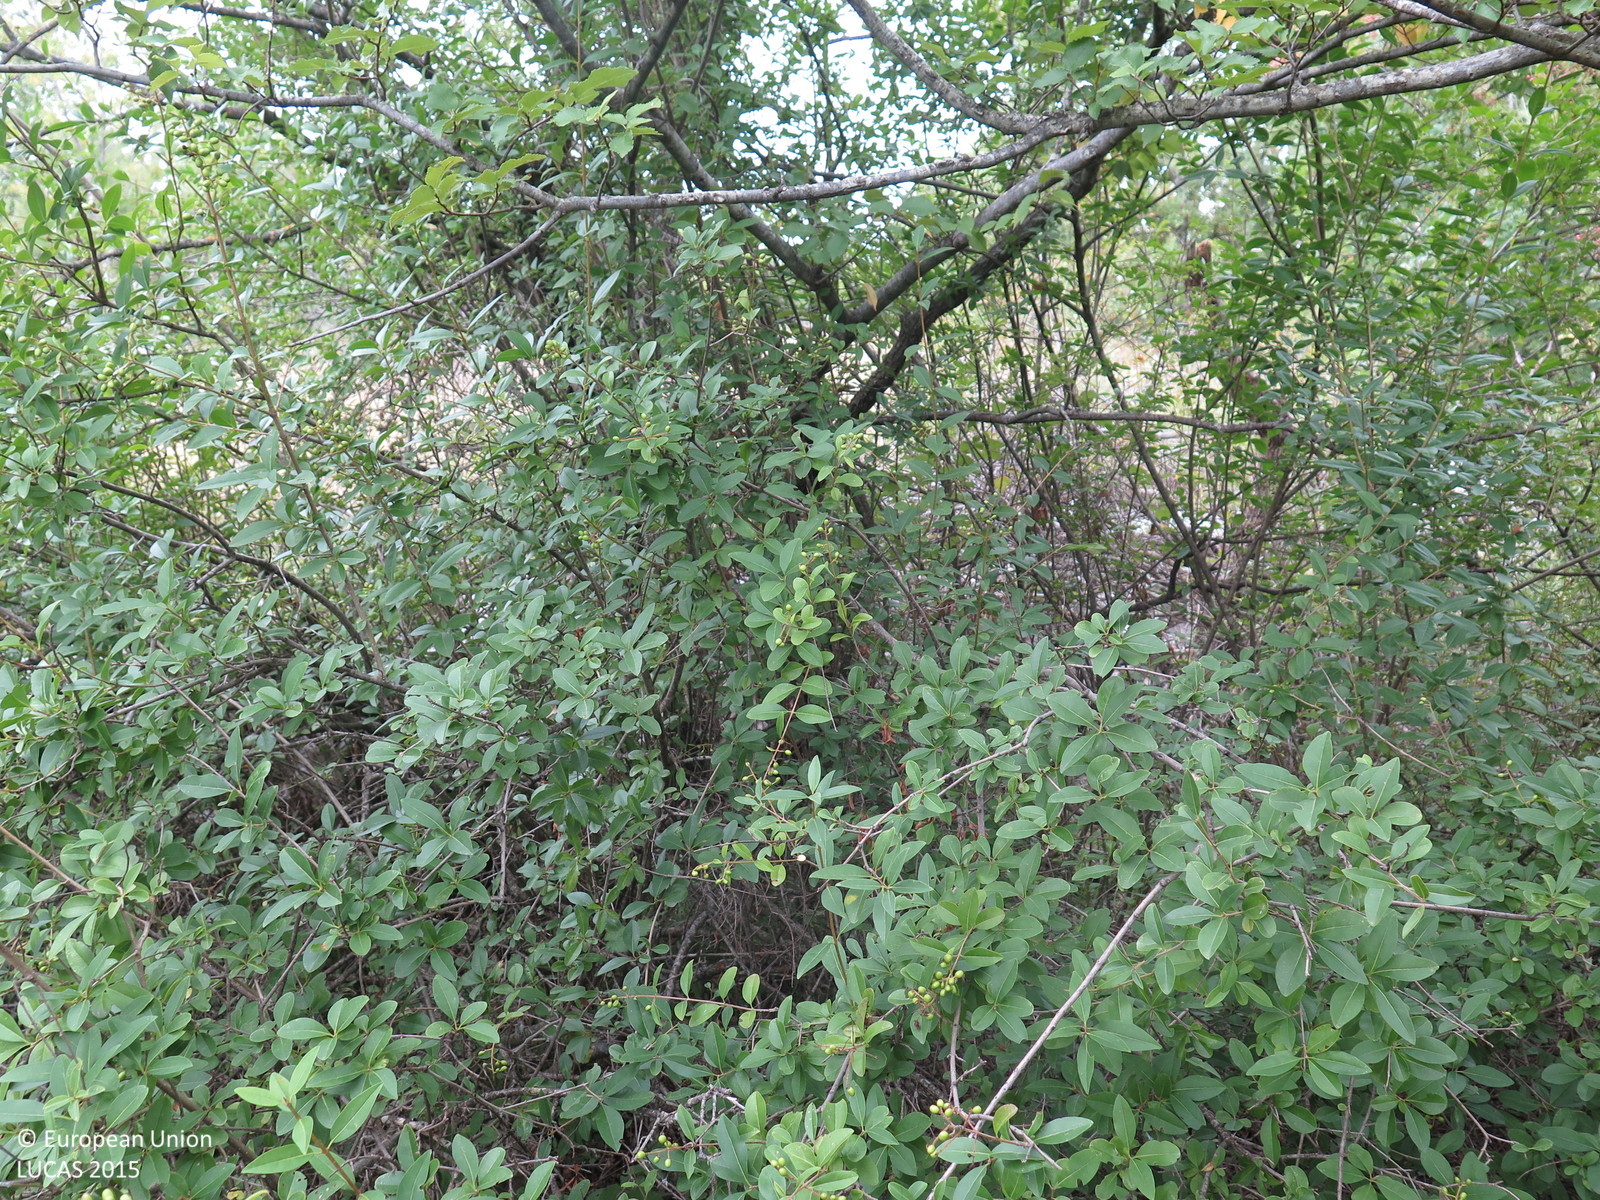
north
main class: Woodland
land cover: Broadleaved woodland
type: thermophilous deciduous forest
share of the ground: > 75 %
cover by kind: broadleaved forest trees 90 %, shrubs 5 %, herbaceous plants 5 %
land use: Abandoned areas
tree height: < 5 m
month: August
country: HR
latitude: 45.1307
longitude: 14.6609
